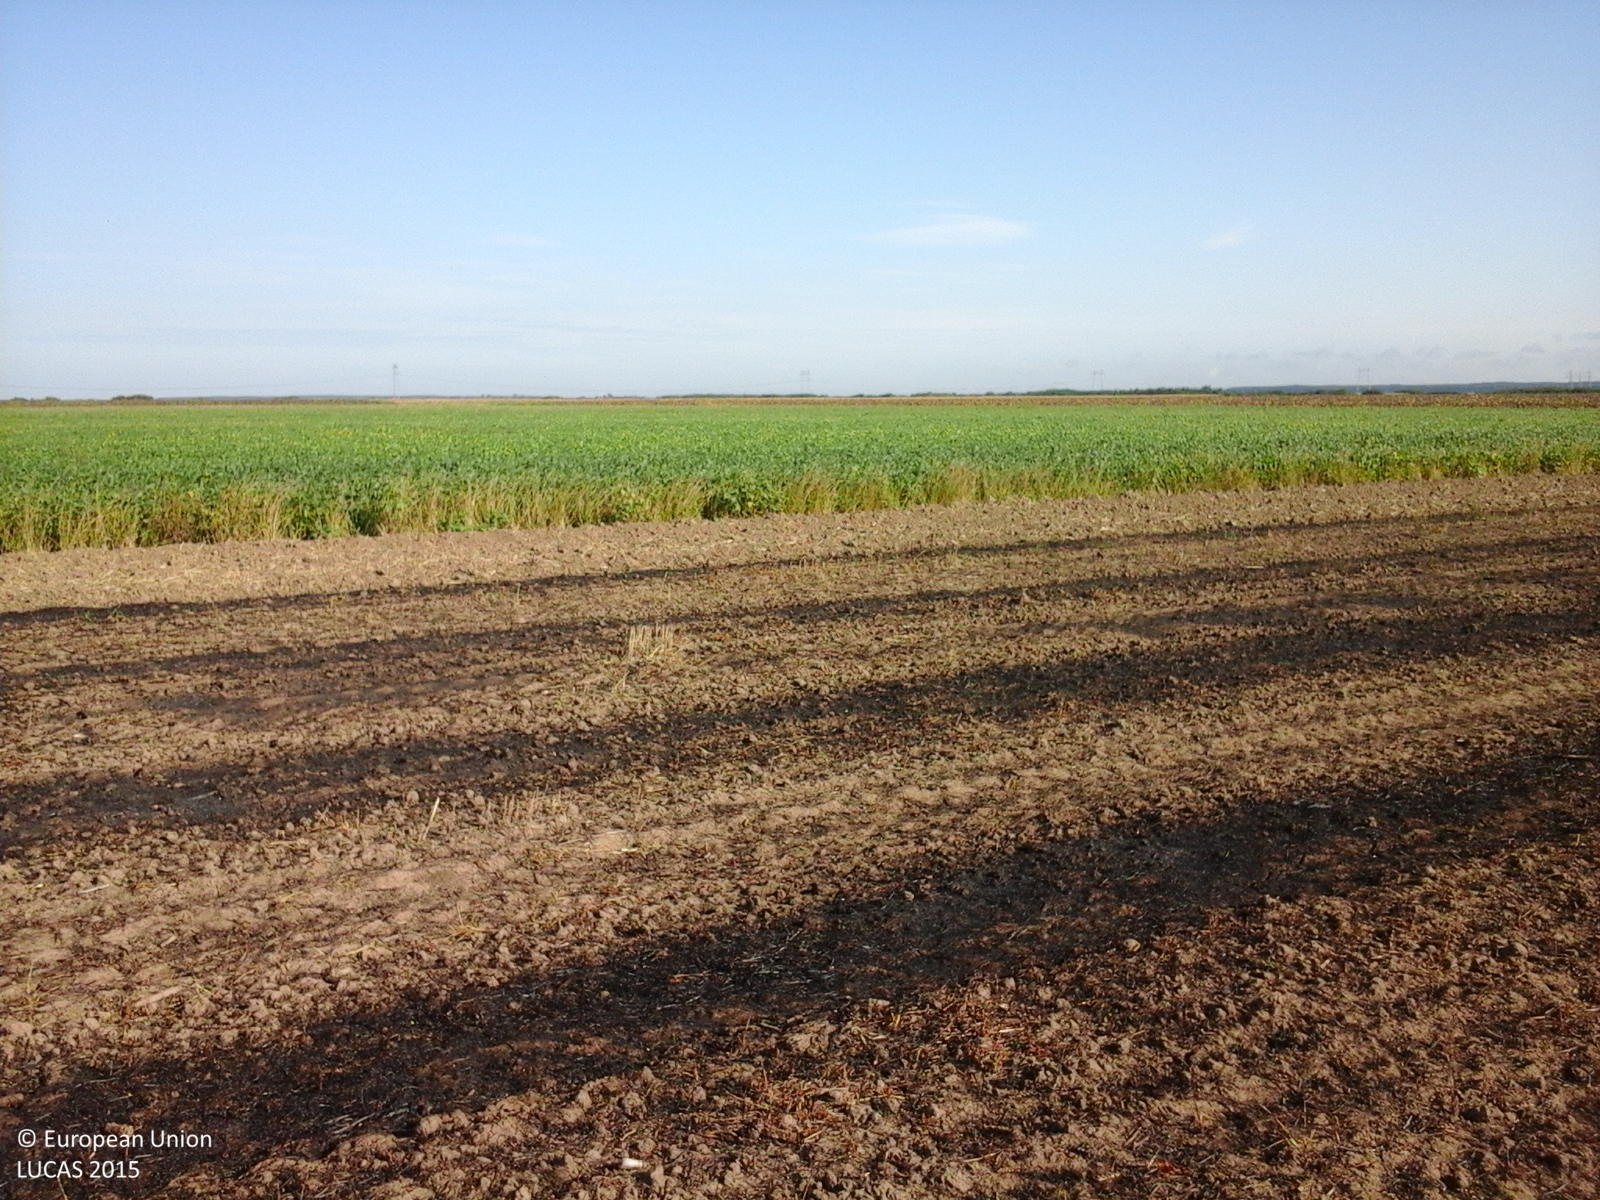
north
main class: Cropland
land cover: Common wheat
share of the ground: < 10 %
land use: Agriculture (excluding fallow land and kitchen gardens)
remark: Burnt area
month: September
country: RO
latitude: 47.5461
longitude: 22.8041
